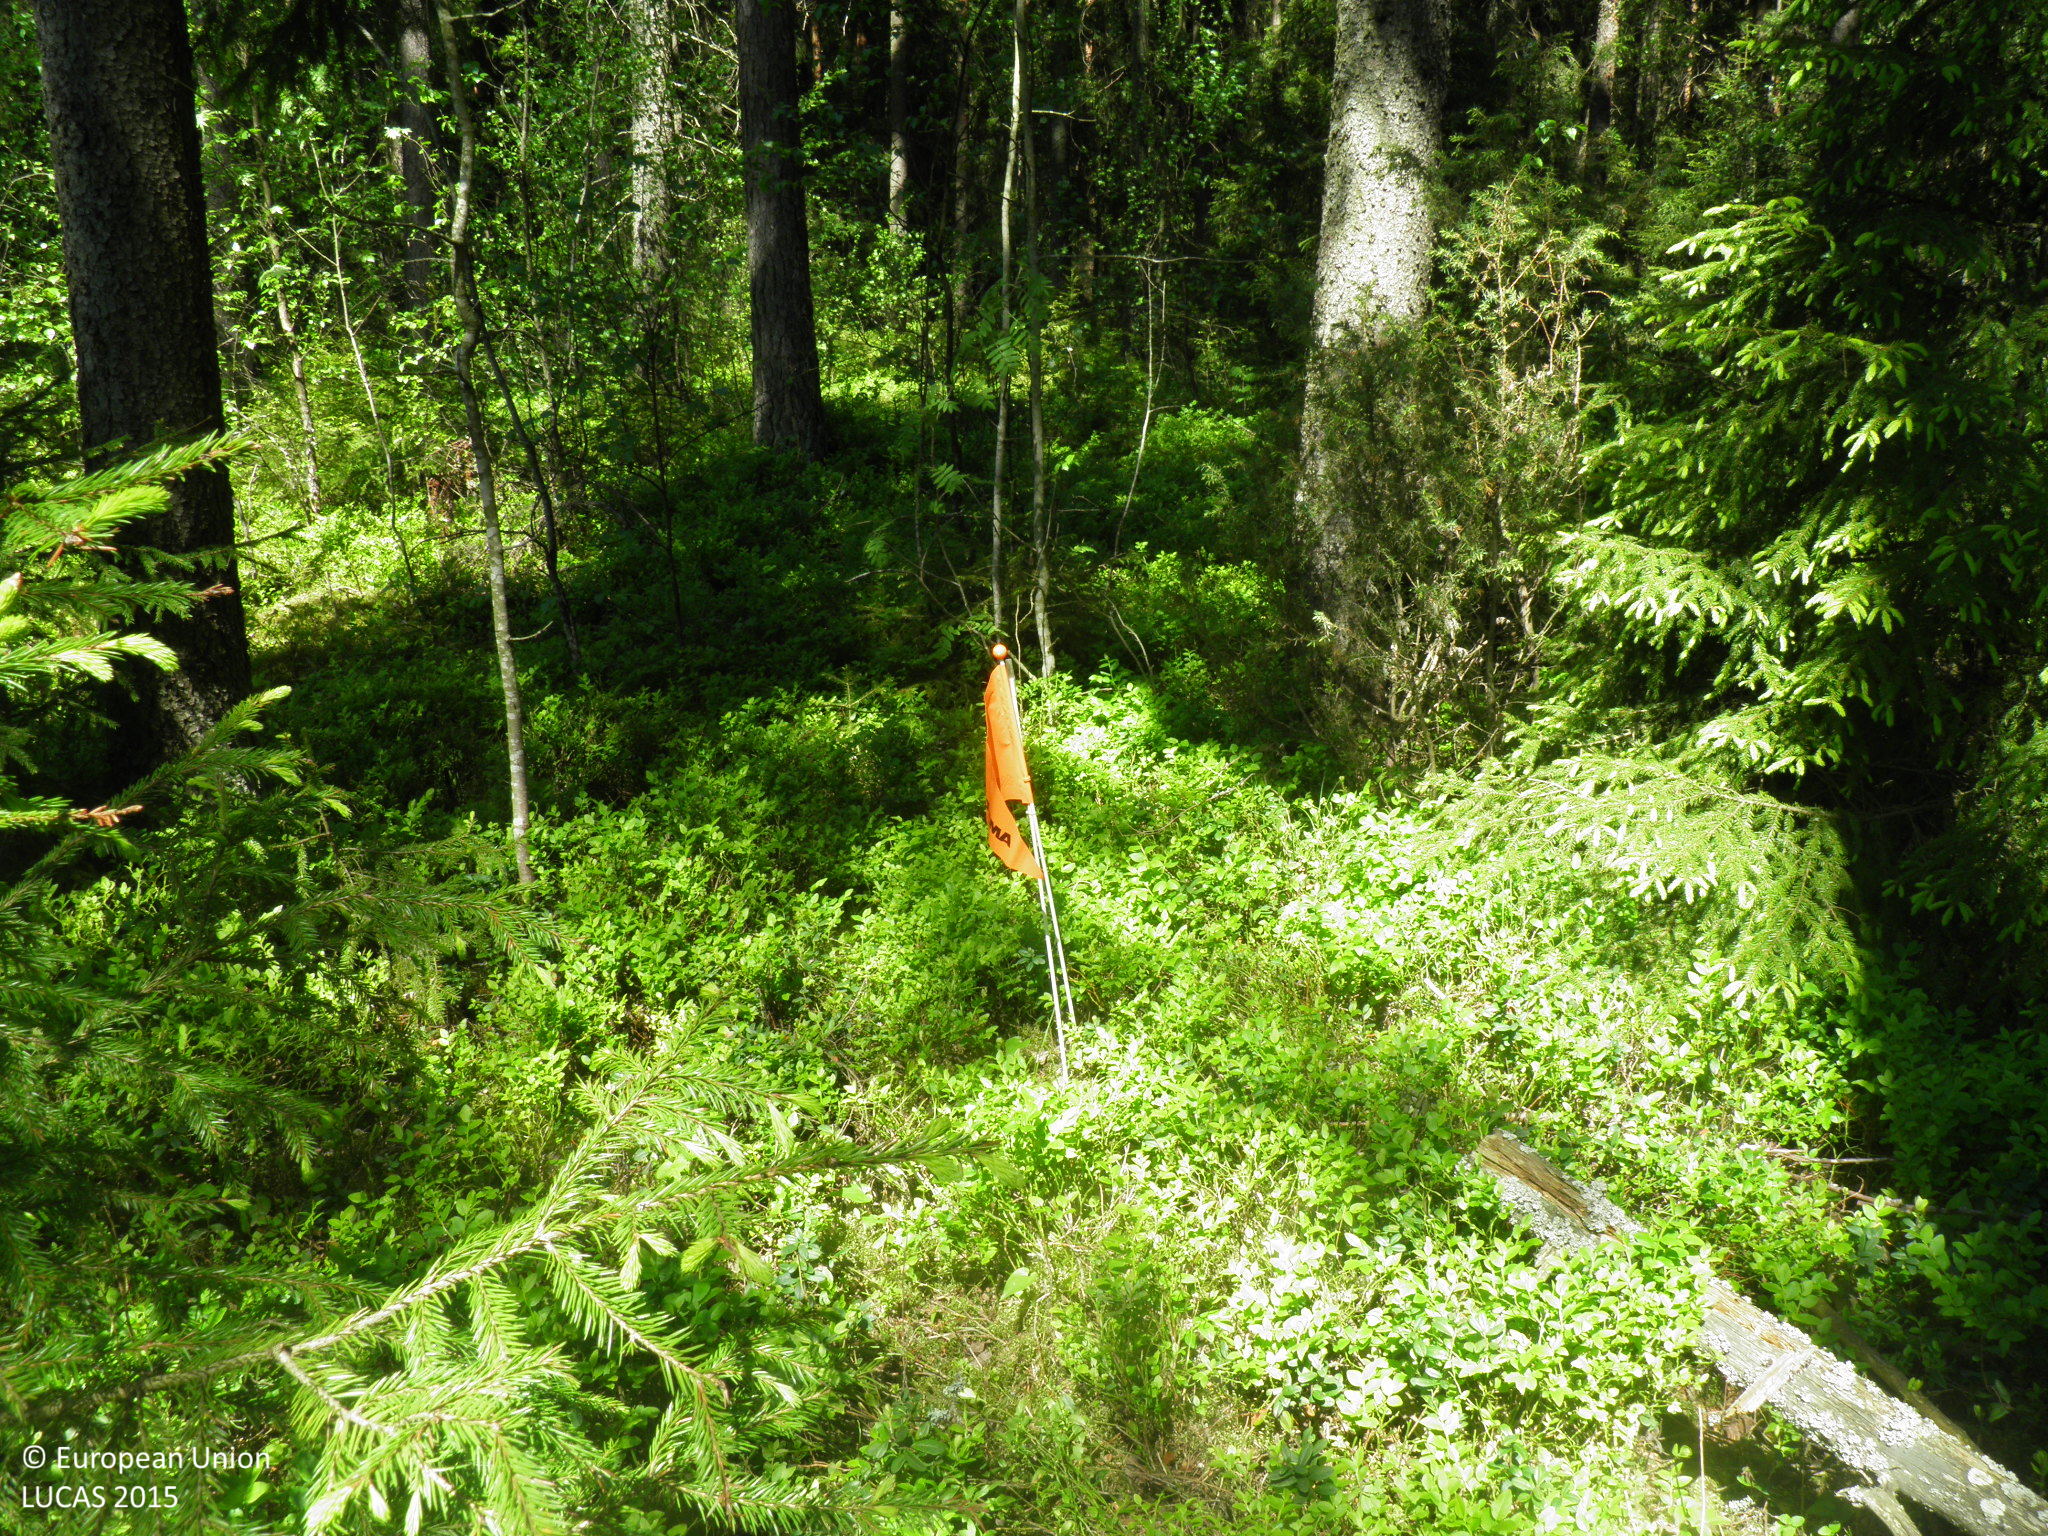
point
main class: Woodland
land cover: Spruce dominated coniferous woodland
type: boreal forest
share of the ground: > 75 %
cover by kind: coniferous forest trees 90 %, broadleaved forest trees 5 %, shrubs 5 %
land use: Forestry
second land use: Amenities, museums, leisure
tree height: > 5 m
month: June
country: FI
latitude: 60.6023
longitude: 22.3585
